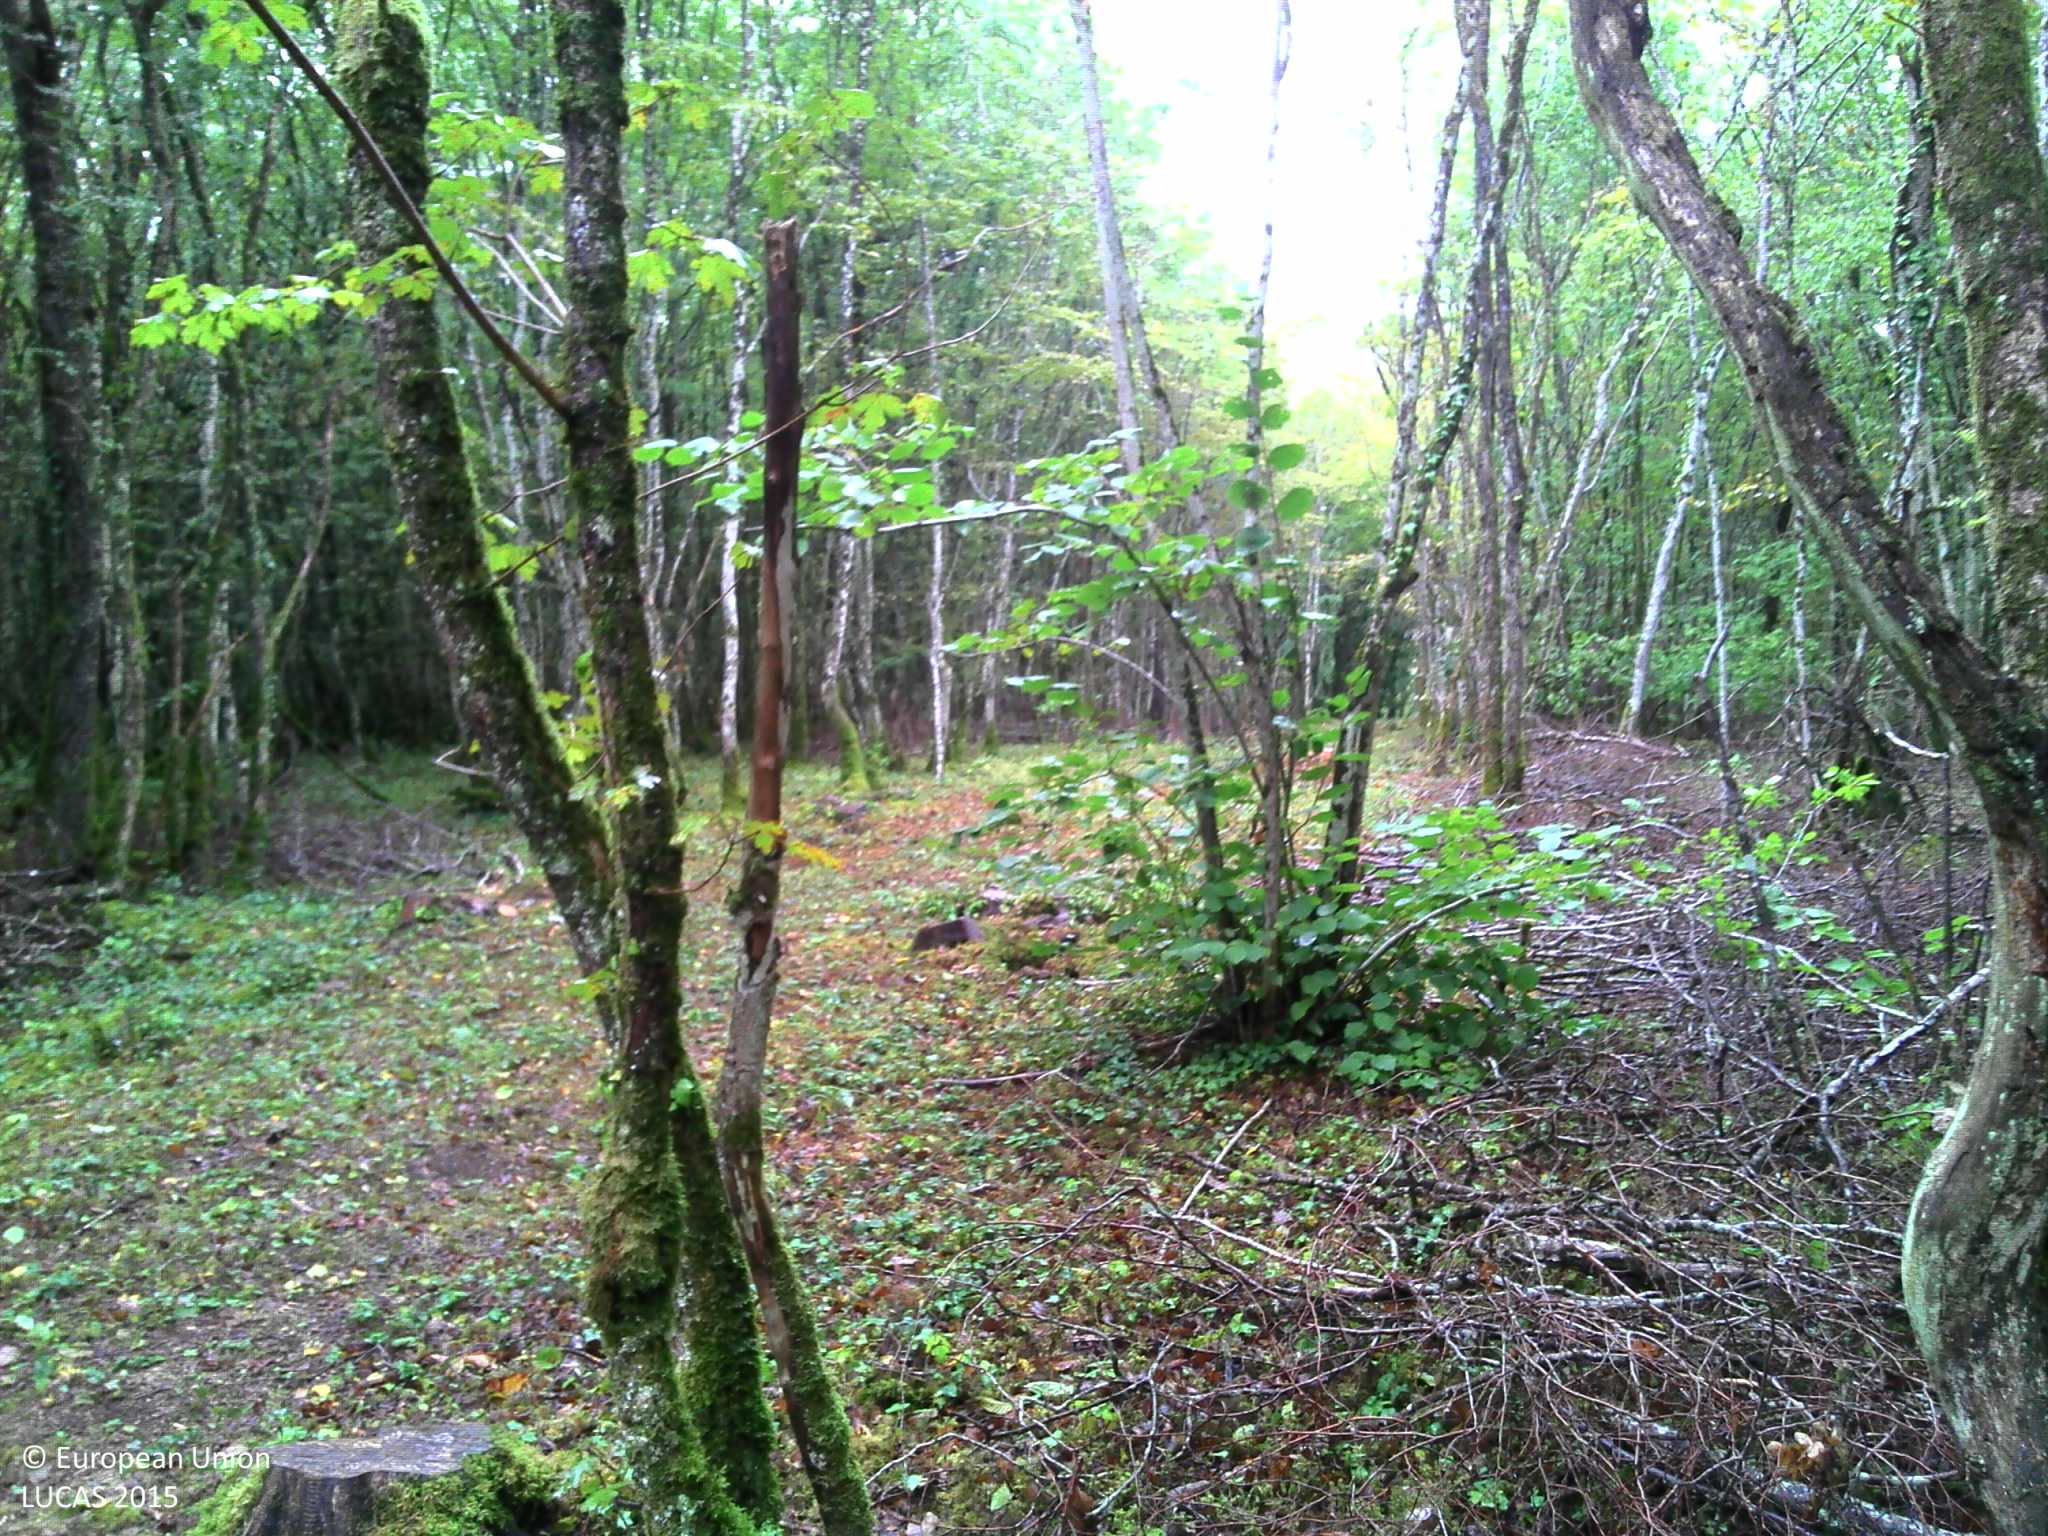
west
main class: Woodland
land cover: Broadleaved woodland
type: mesophytic deciduous forest
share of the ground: > 75 %
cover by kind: broadleaved forest trees 85 %, herbaceous plants 15 %
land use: Forestry
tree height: > 5 m
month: September
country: FR
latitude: 47.3747
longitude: 4.3439
